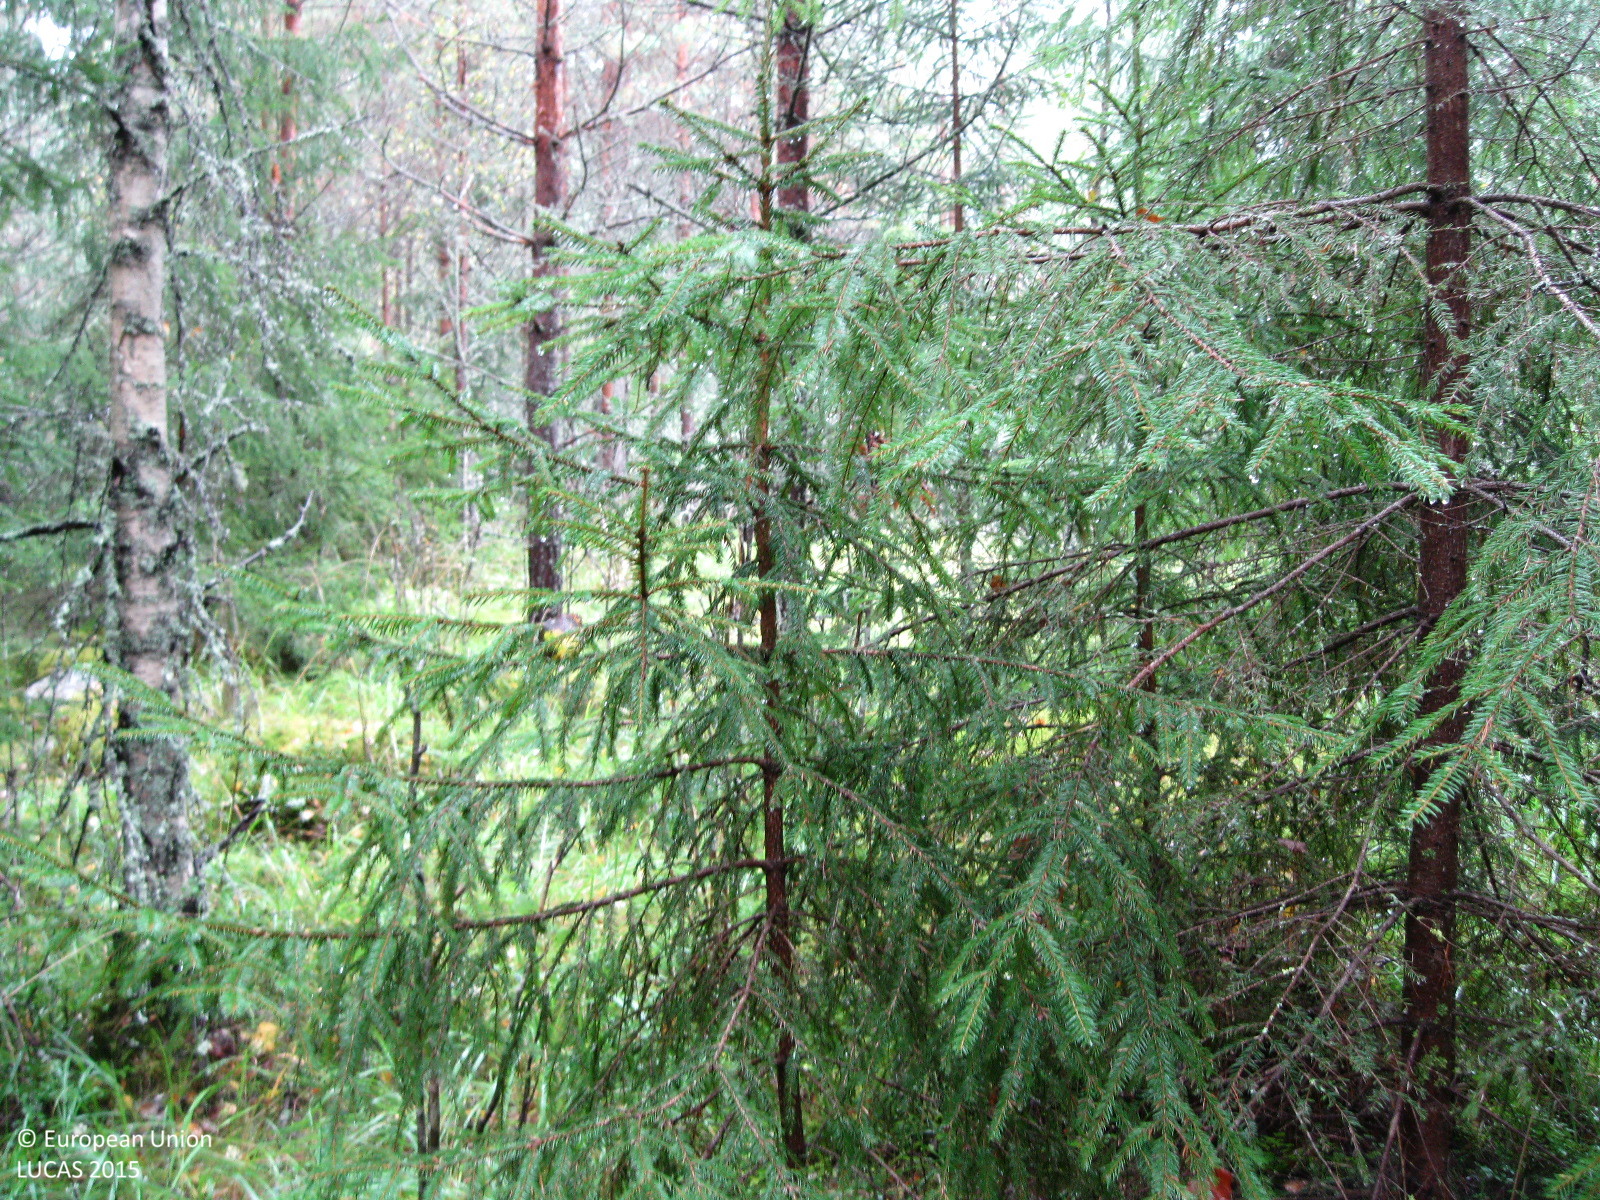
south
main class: Woodland
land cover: Other mixed woodland
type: boreal forest
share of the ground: > 75 %
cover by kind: coniferous forest trees 50 %, broadleaved forest trees 35 %, shrubs 5 %, herbaceous plants 5 %, lichens and mosses 5 %
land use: Semi-natural and natural areas not in use
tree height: > 5 m
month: September
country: FI
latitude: 60.3487
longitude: 24.6252
